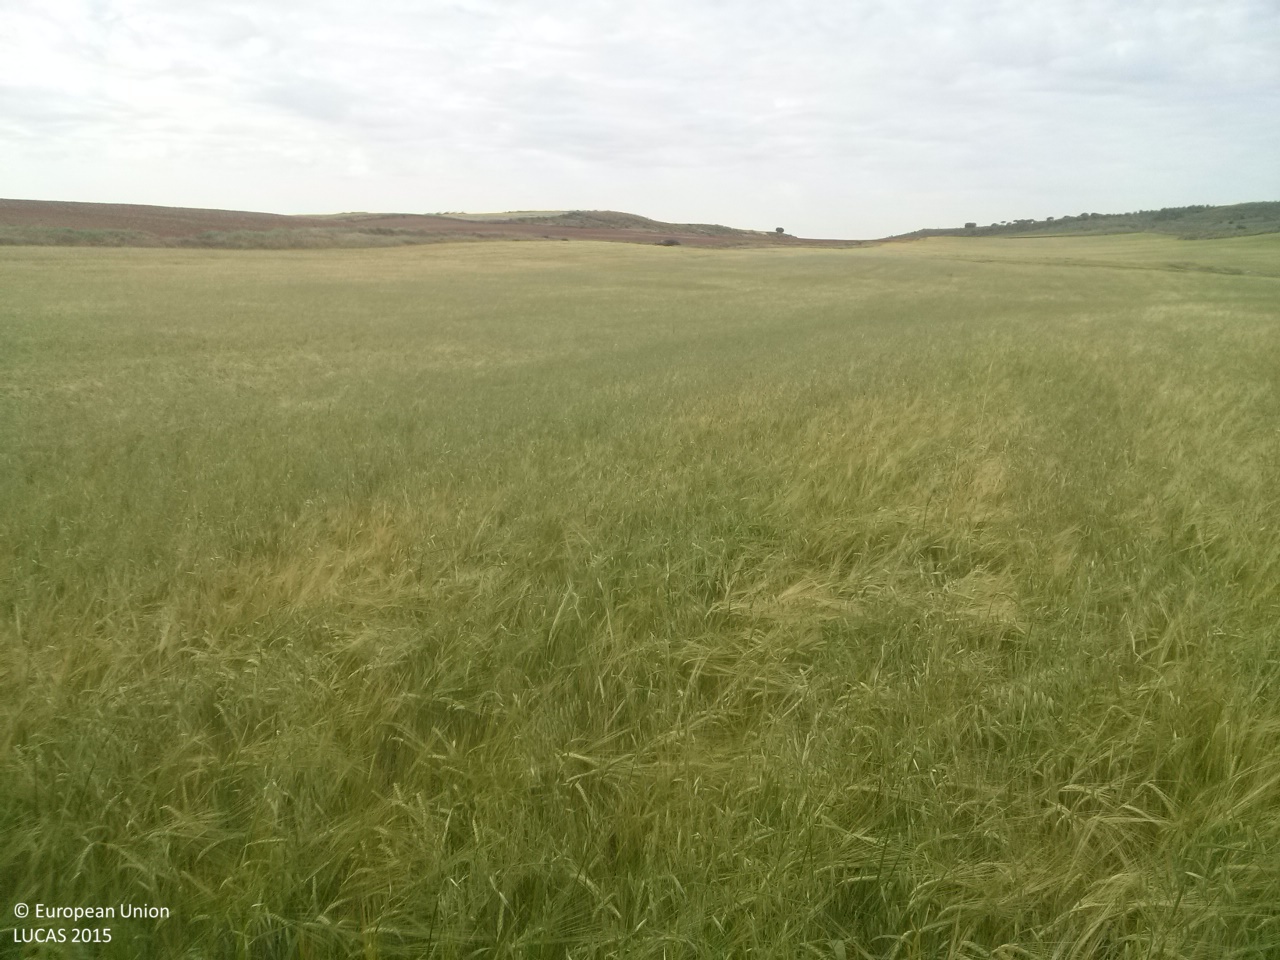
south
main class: Cropland
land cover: Barley
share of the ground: > 75 %
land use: Agriculture (excluding fallow land and kitchen gardens)
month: May
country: ES
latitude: 40.0692
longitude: -2.9094
